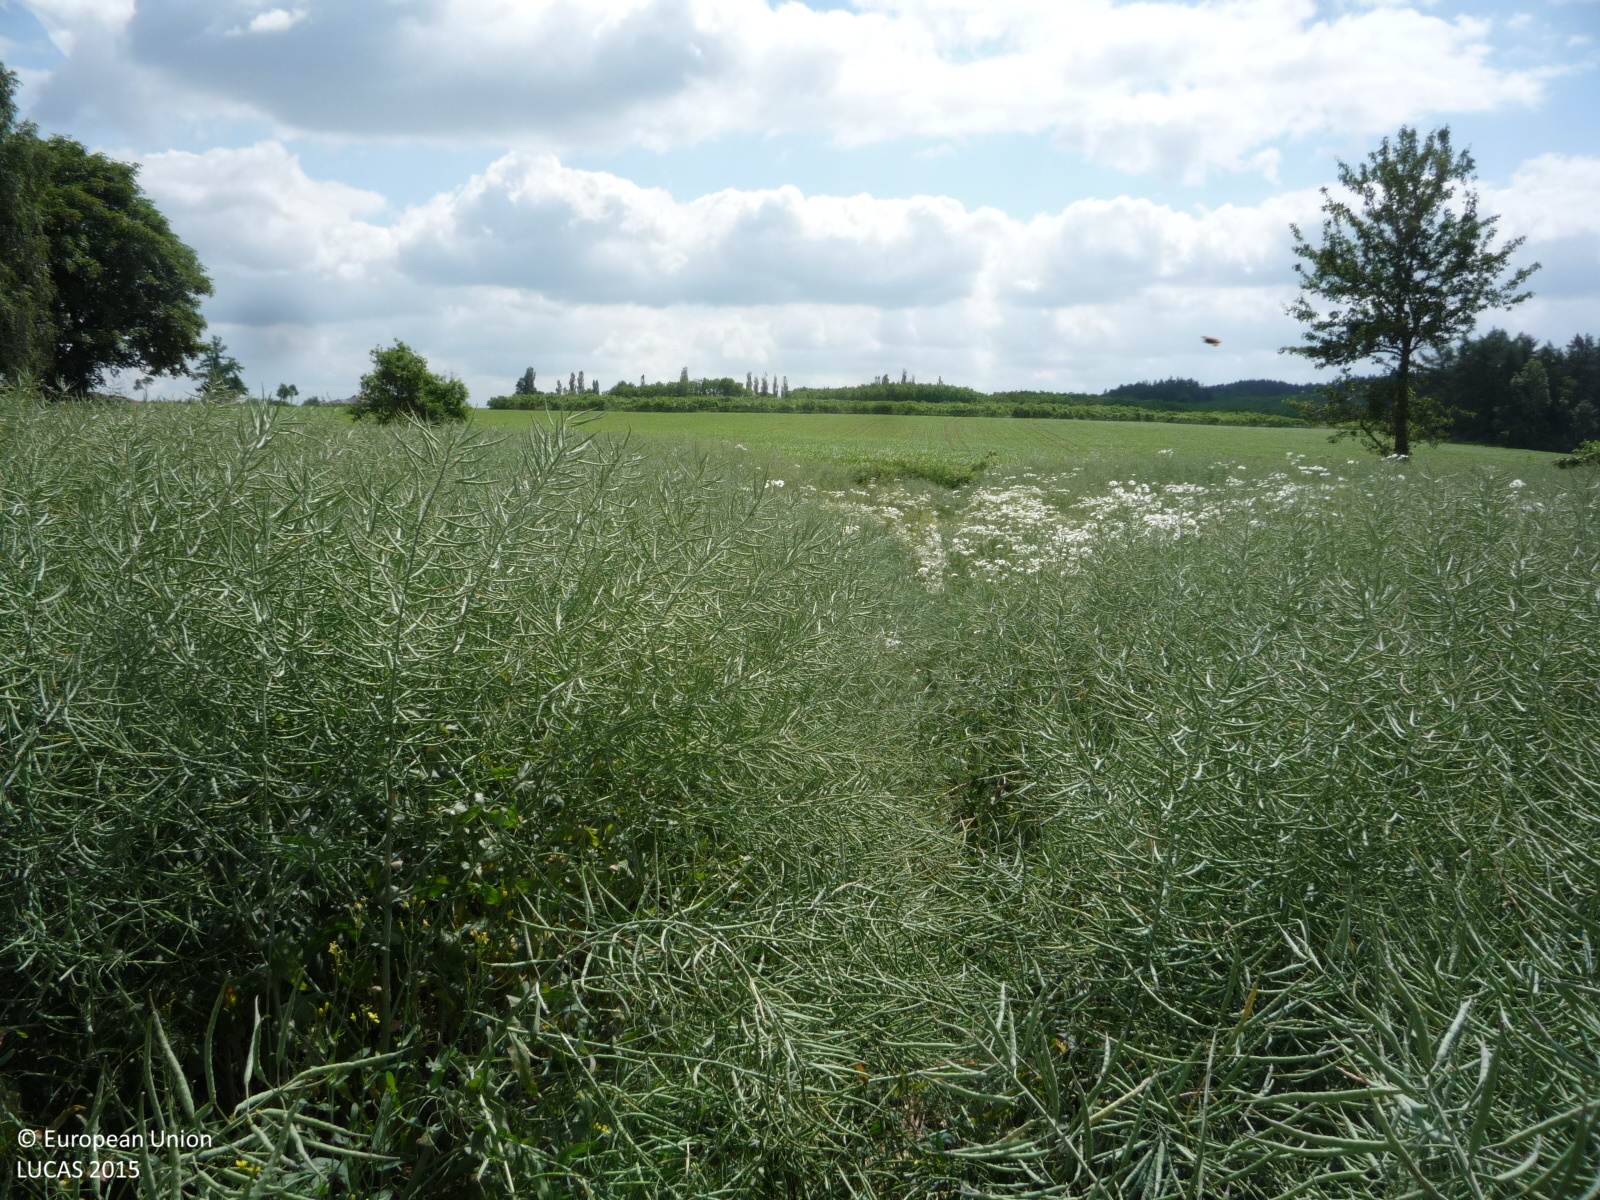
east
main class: Cropland
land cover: Rape and turnip rape
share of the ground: > 75 %
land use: Agriculture (excluding fallow land and kitchen gardens)
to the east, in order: Rape and turnip rape; Grass margins; Paved roads, cycling and walking lanes; Ditches and canals; Grass margins; Maize
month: June
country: CZ
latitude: 49.7342
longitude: 14.9557
